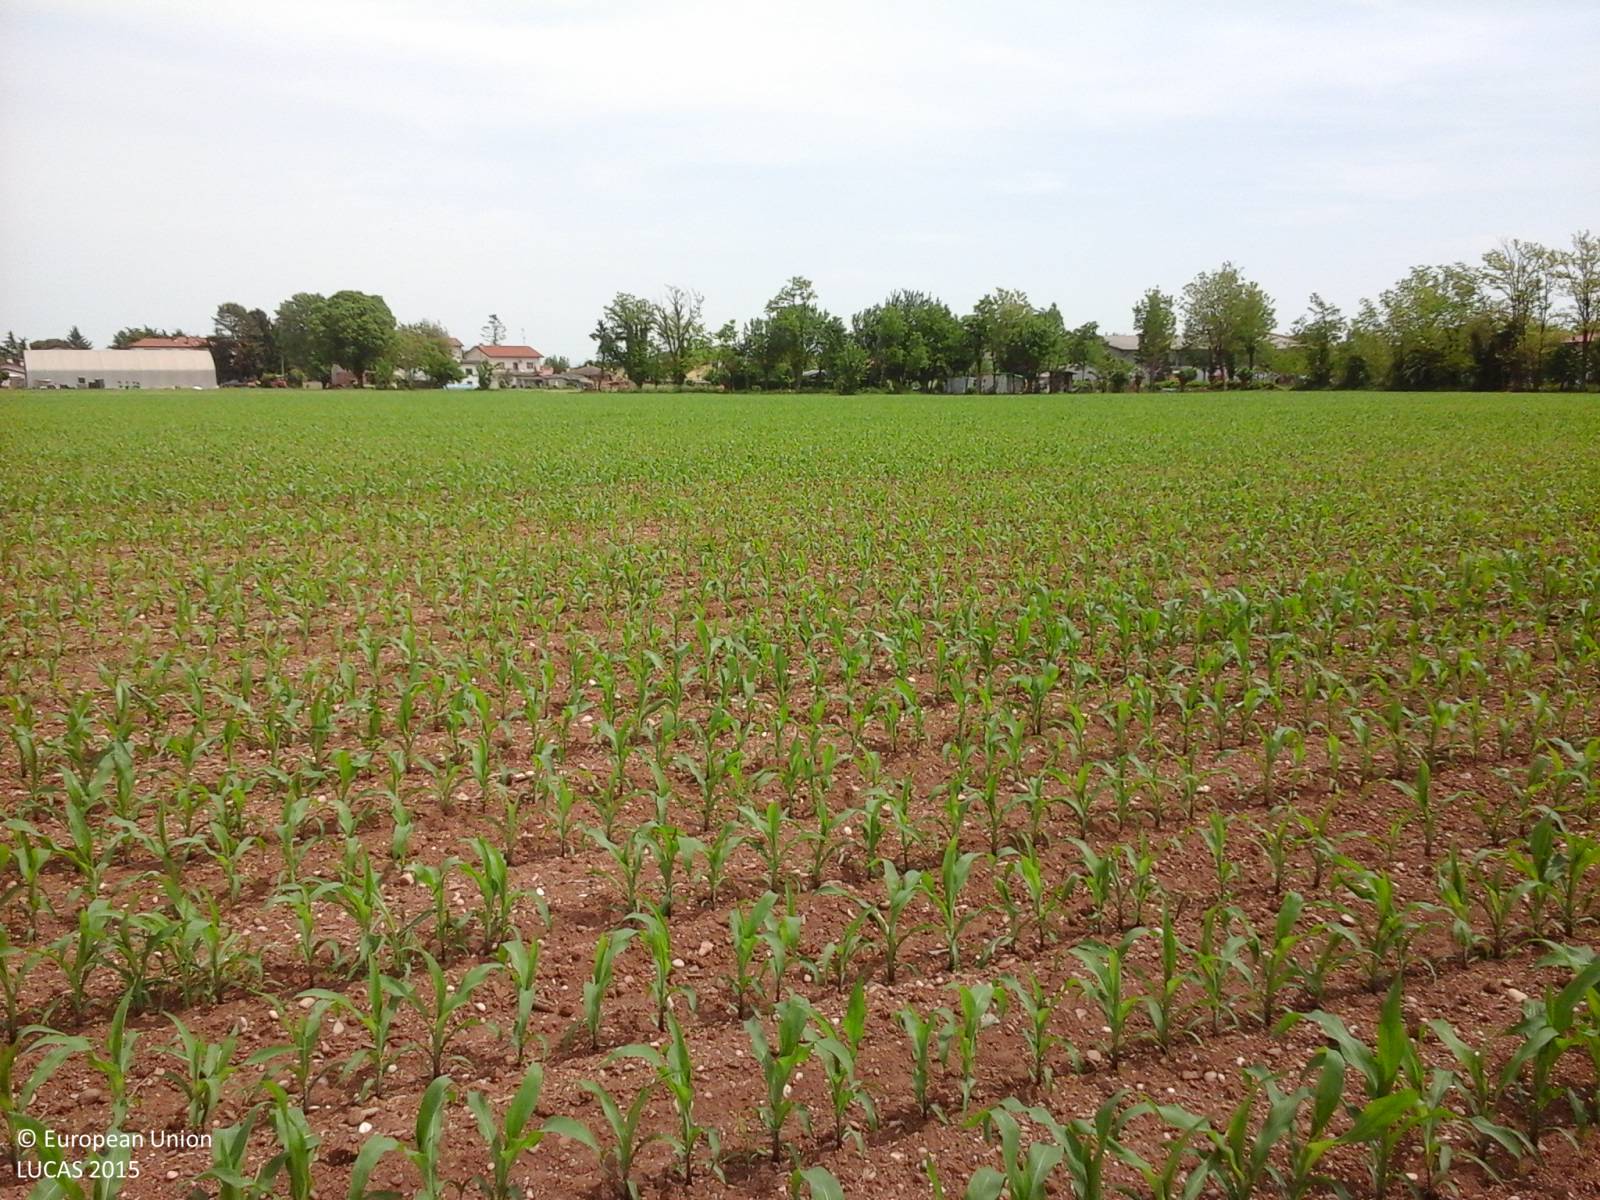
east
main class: Cropland
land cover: Maize
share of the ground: 25 - 50 %
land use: Agriculture (excluding fallow land and kitchen gardens)
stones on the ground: 10 - 25 %
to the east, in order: Maize; Tracks; Grassland without tree/shrub cover
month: May
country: IT
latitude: 45.9066
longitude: 13.2060
